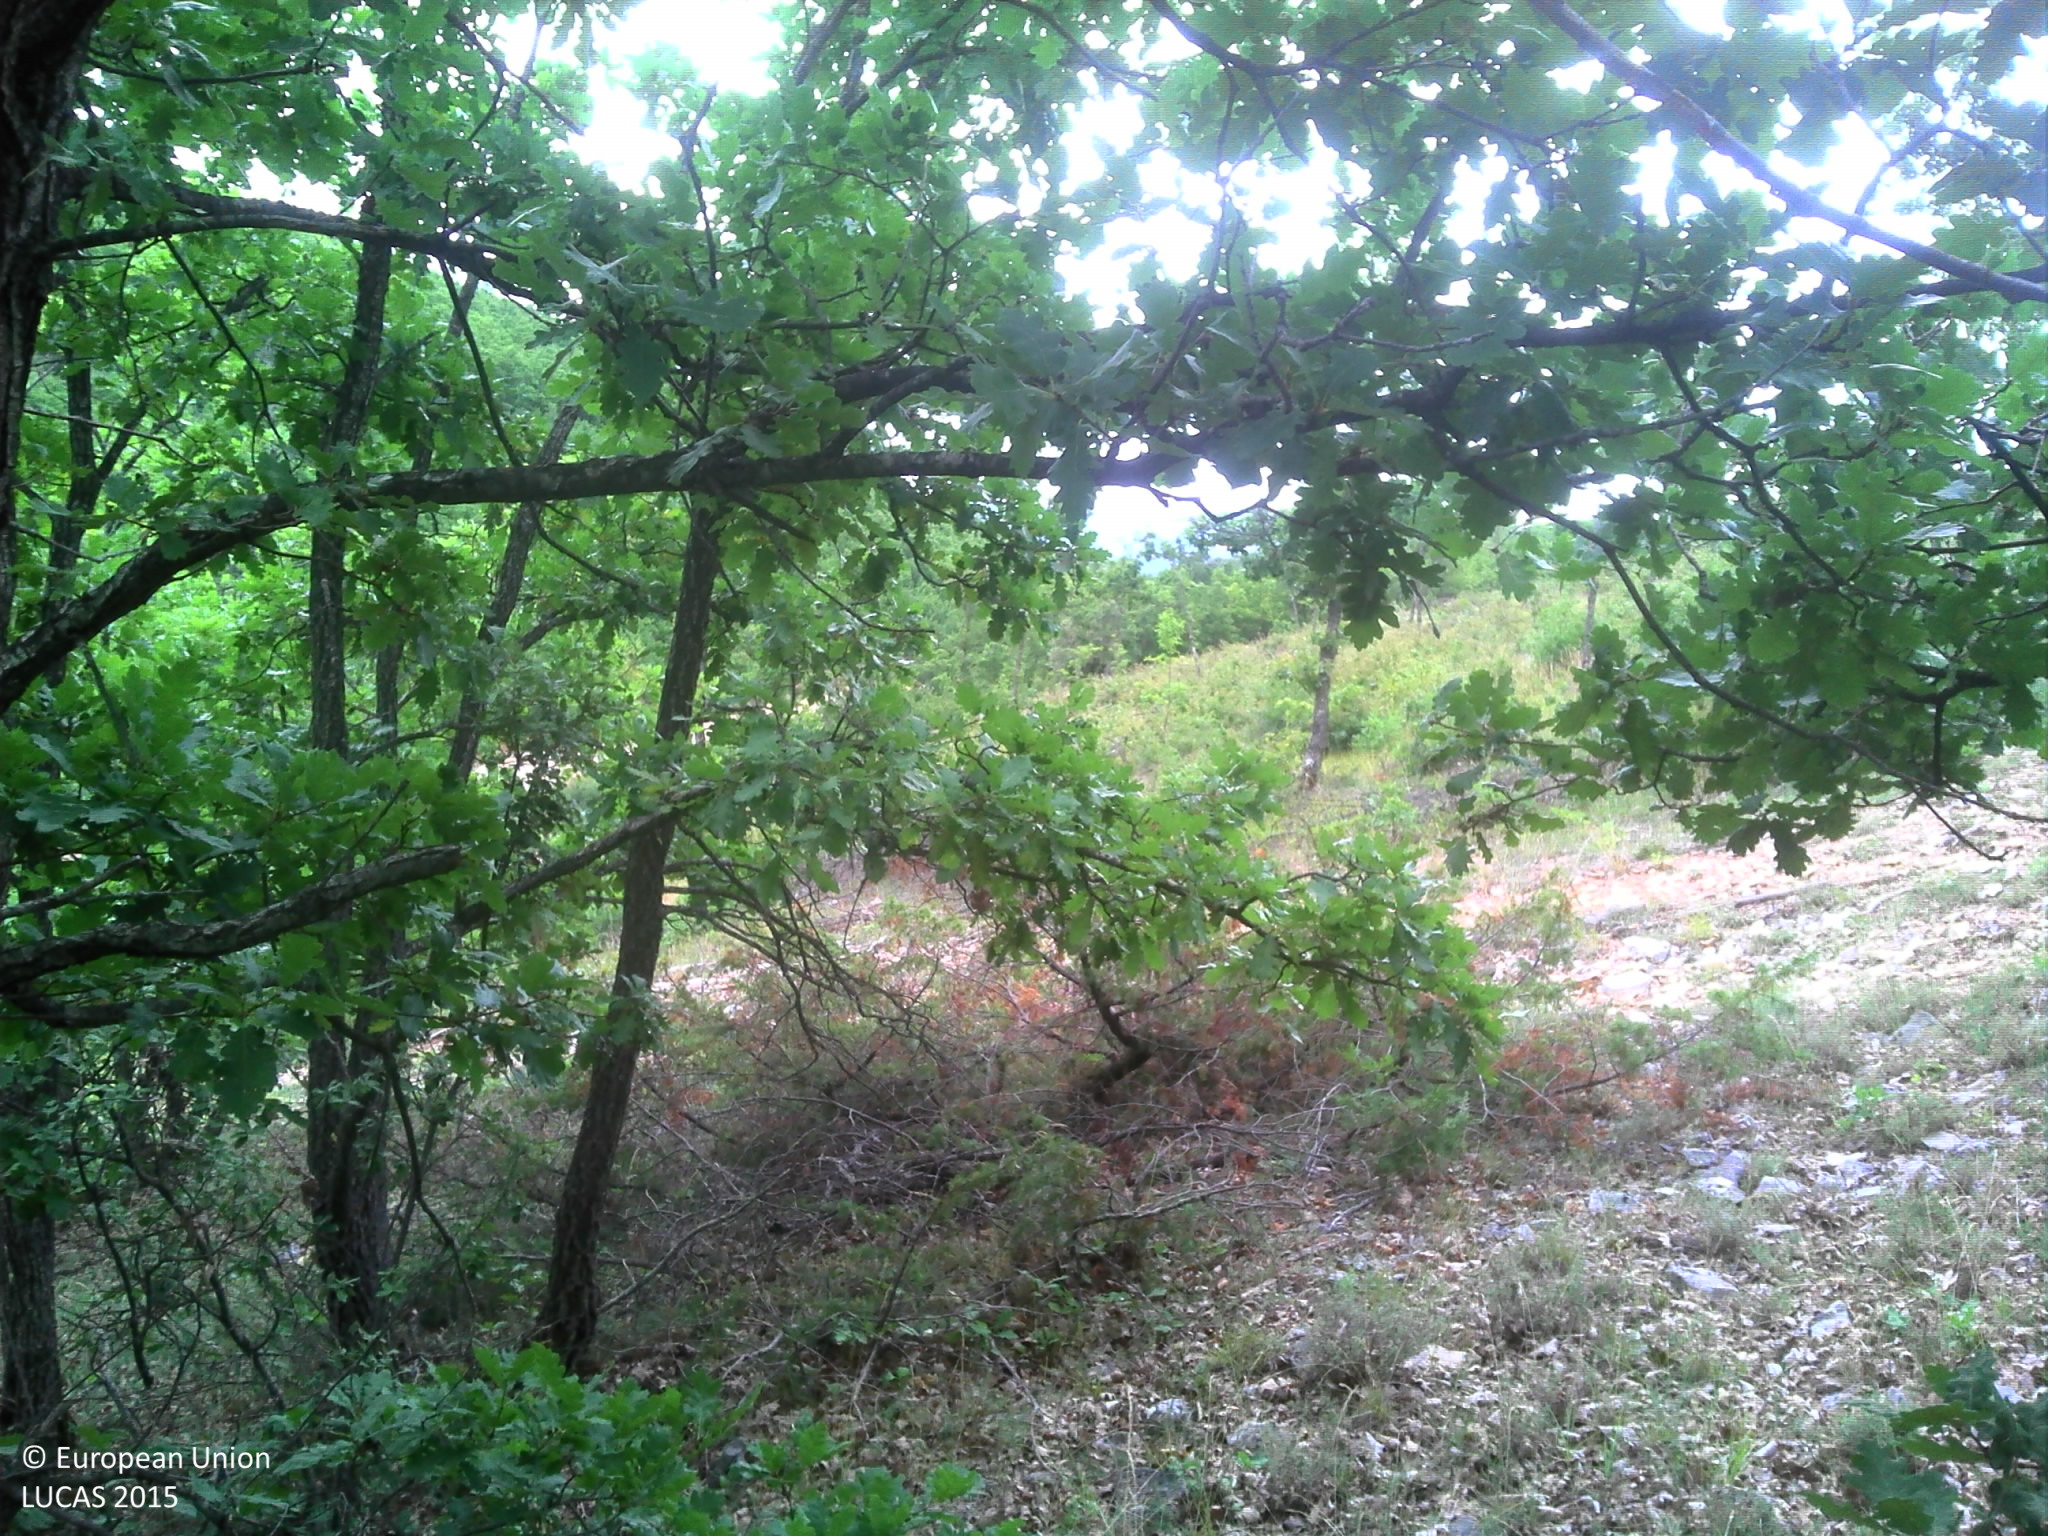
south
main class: Woodland
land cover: Broadleaved woodland
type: thermophilous deciduous forest
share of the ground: > 75 %
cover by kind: broadleaved forest trees 70 %, herbaceous plants 10 %, consolidated bare surface 10 %
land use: Forestry
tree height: > 5 m
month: July
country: FR
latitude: 44.0216
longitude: 5.5794
